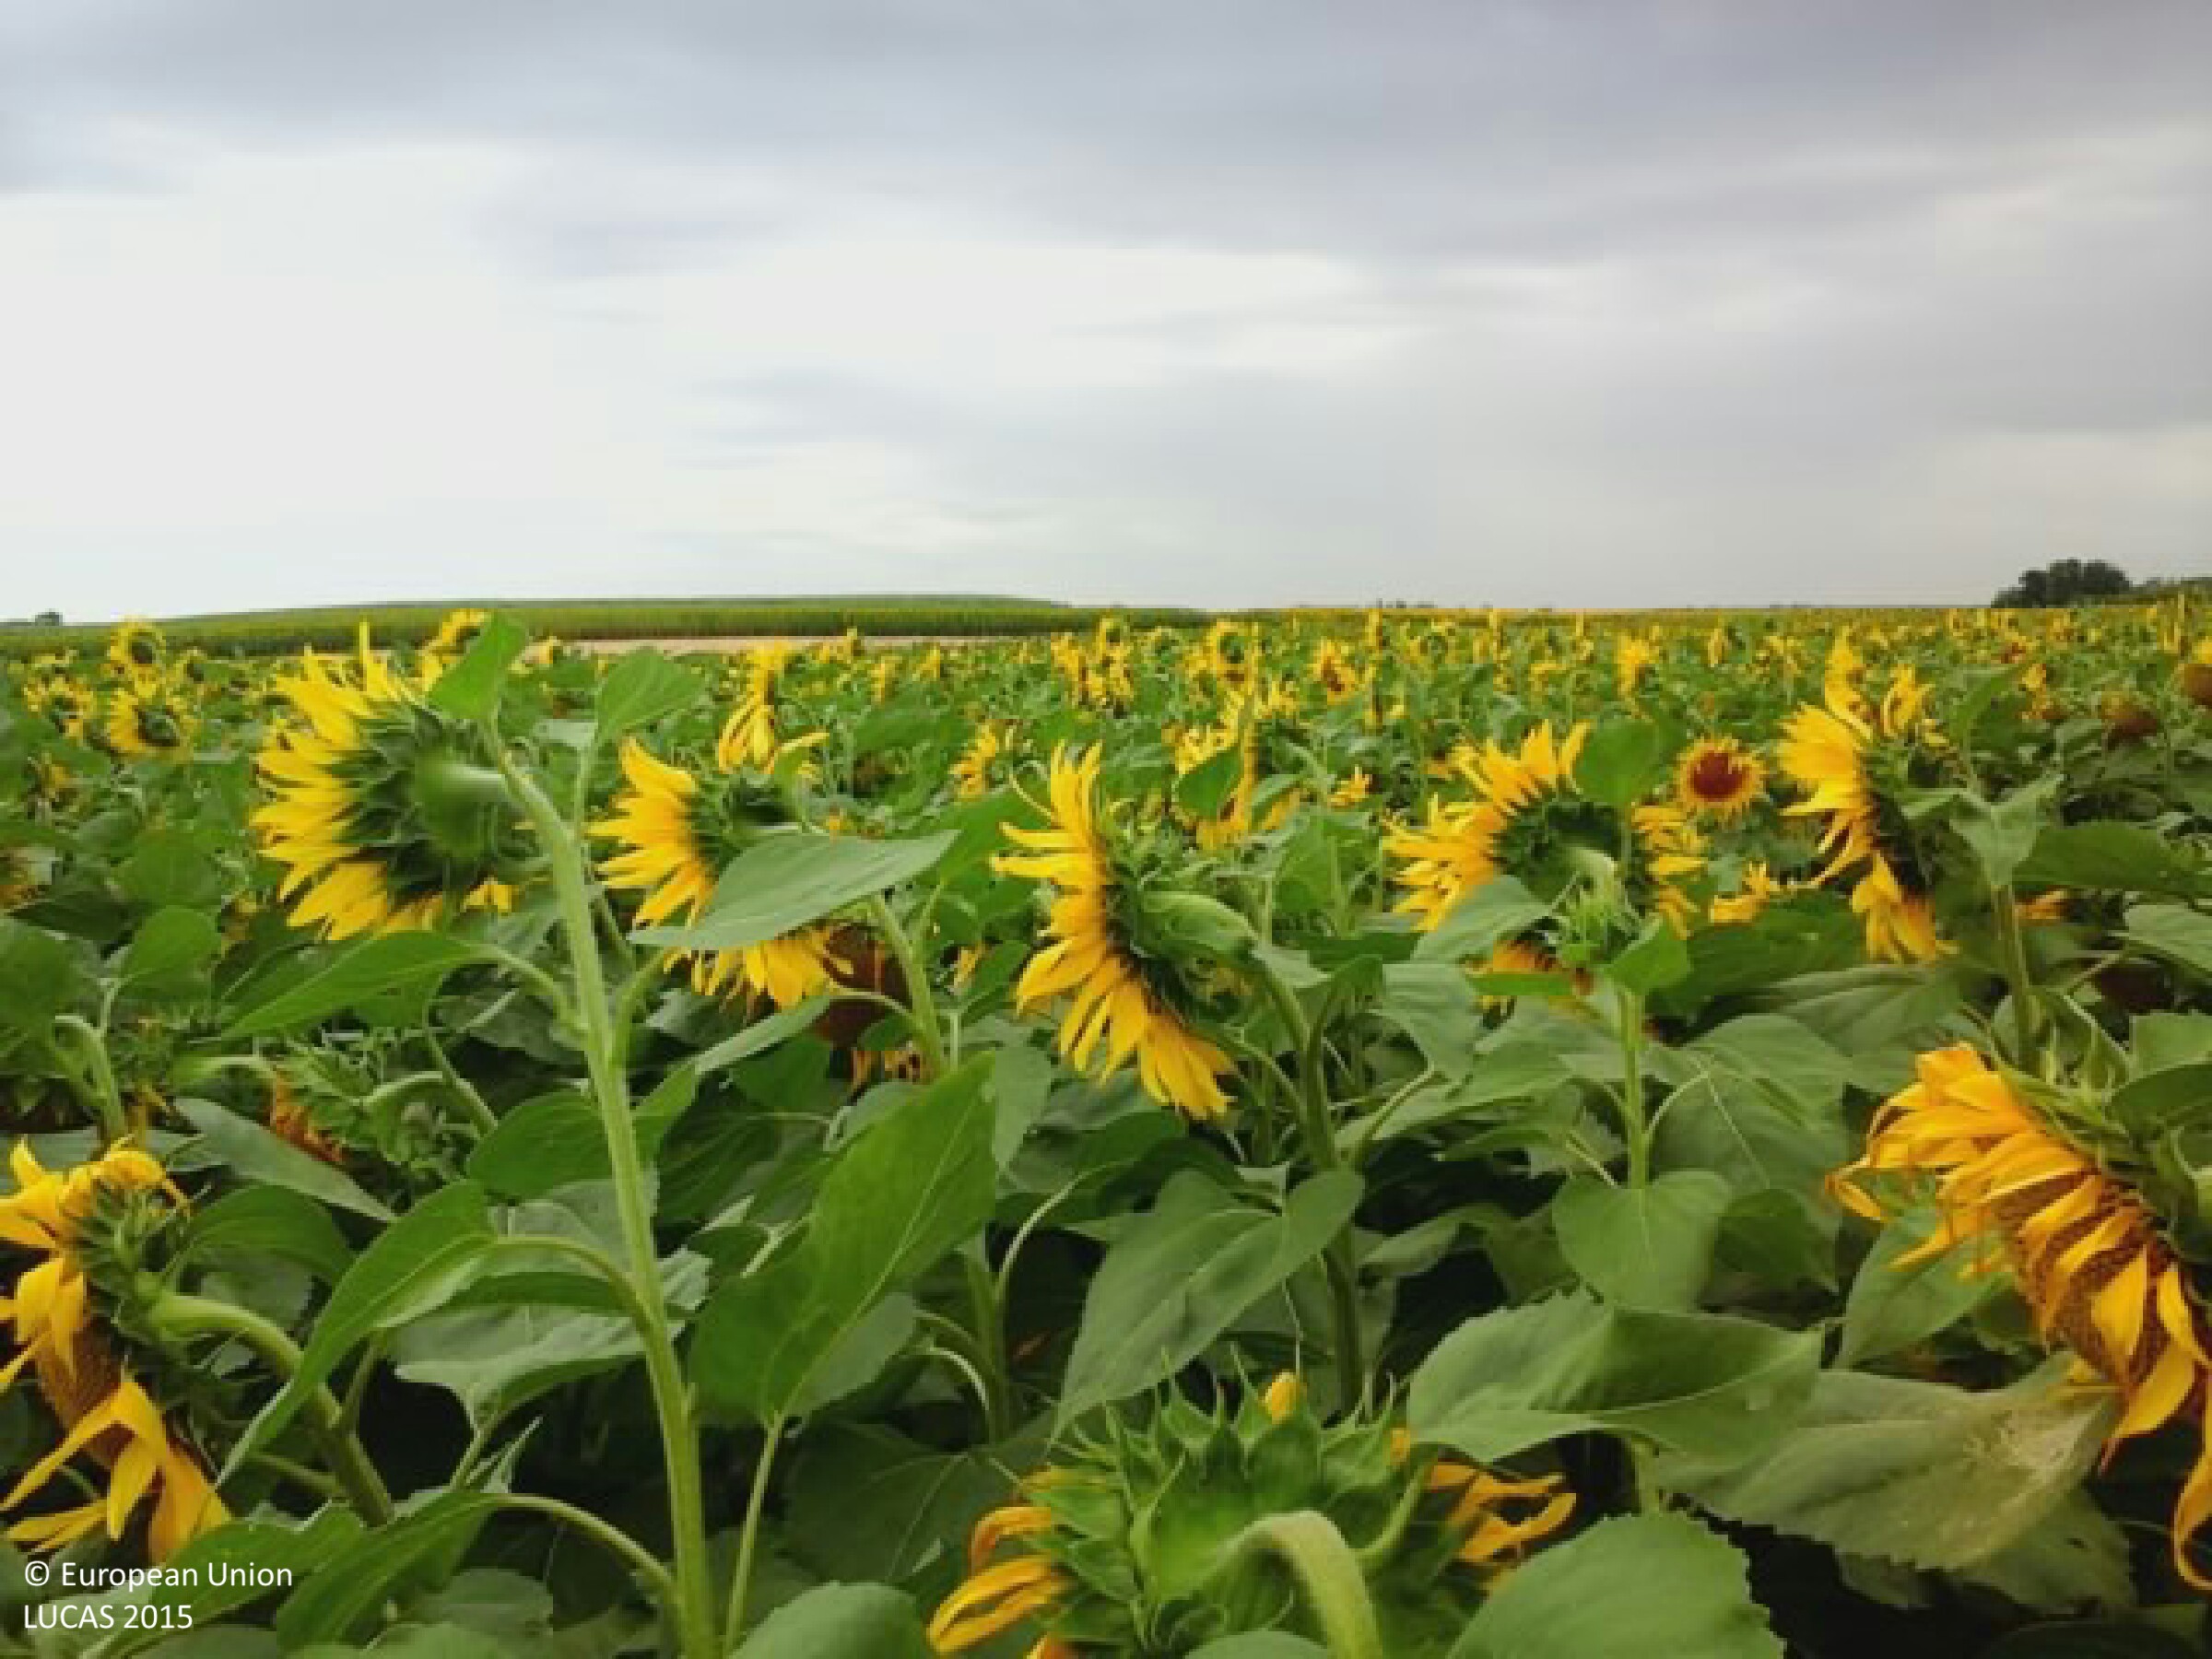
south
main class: Cropland
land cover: Sunflower
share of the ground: > 75 %
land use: Agriculture (excluding fallow land and kitchen gardens)
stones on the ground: < 10 %
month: July
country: HU
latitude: 46.2384
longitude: 19.4699
